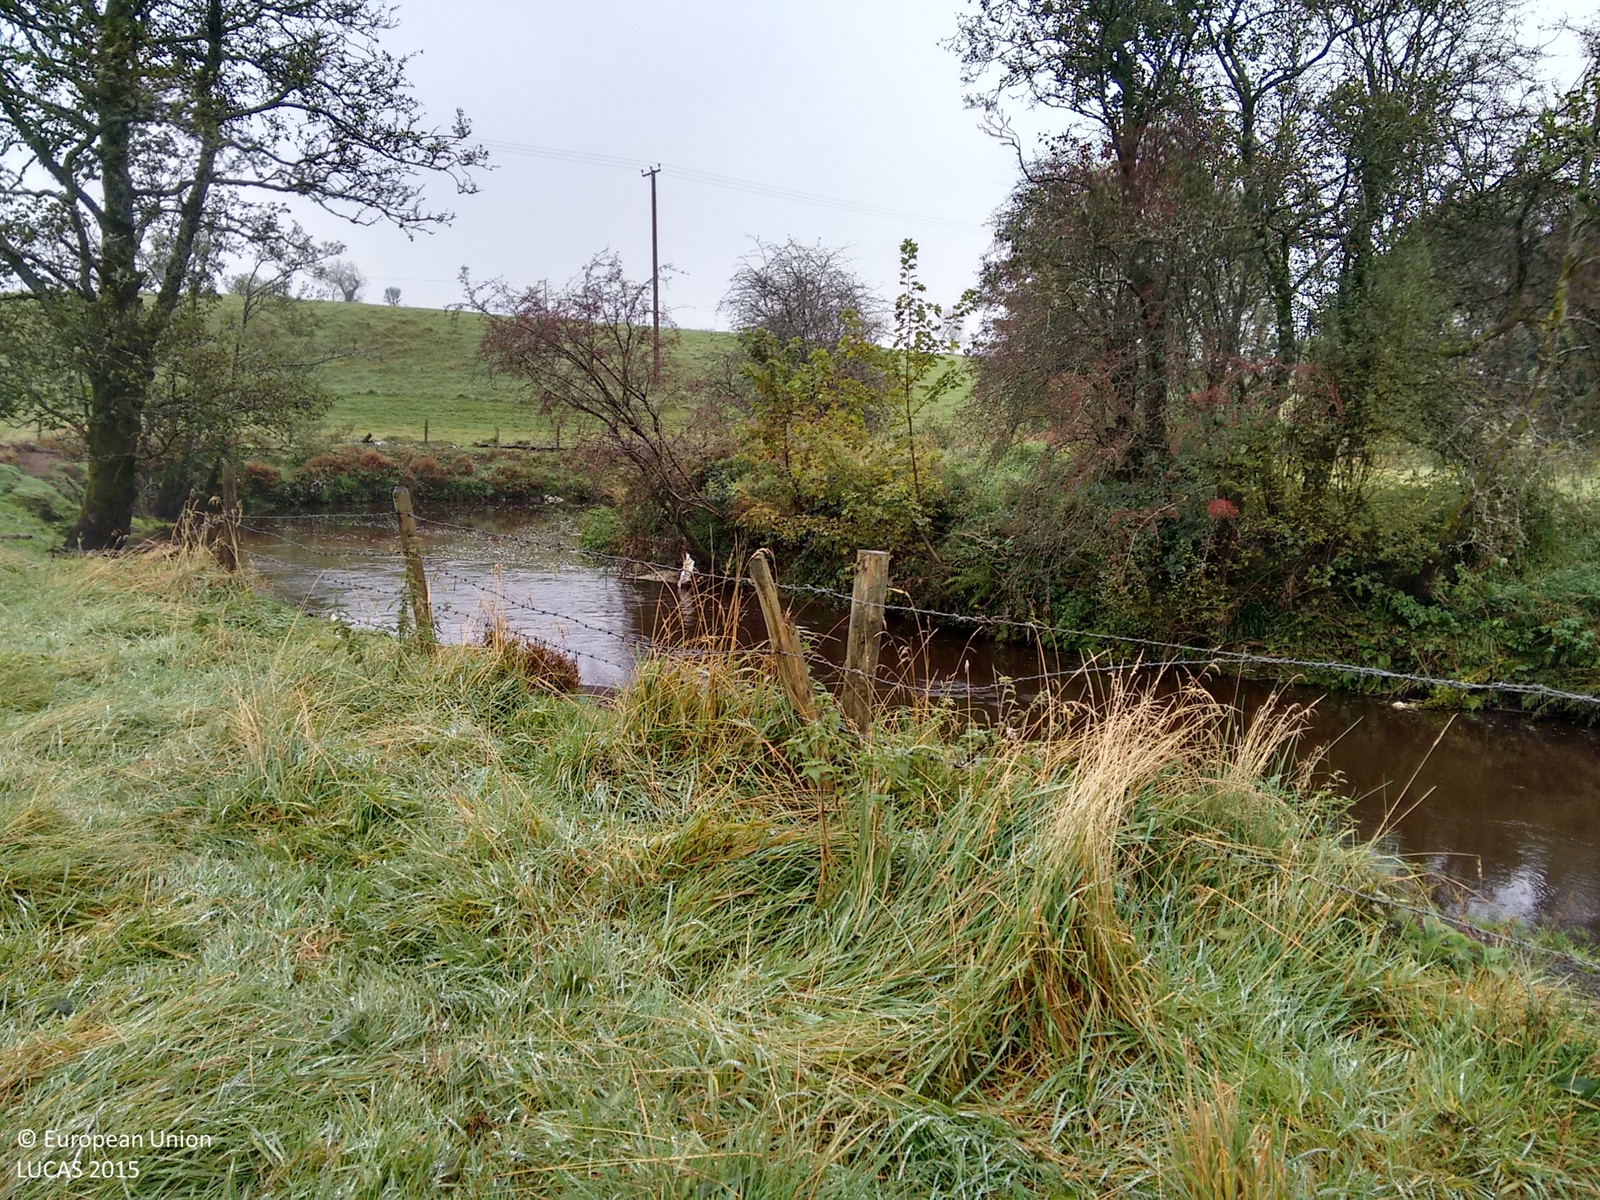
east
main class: Grassland
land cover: Grassland without tree/shrub cover
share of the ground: > 75 %
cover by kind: herbaceous plants 100 %
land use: Agriculture (excluding fallow land and kitchen gardens)
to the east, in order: Grassland without tree/shrub cover; Spruce dominated mixed woodland; Grassland with sparse tree/shrub cover; Spruce dominated coniferous woodland; Grassland without tree/shrub cover; Lines of trees; Inland fresh running water; Grass margins; Fences; Grassland without tree/shrub cover; Electric lines; Grassland without tree/shrub cover
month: October
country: GB
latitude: 54.5351
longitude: -7.4477
